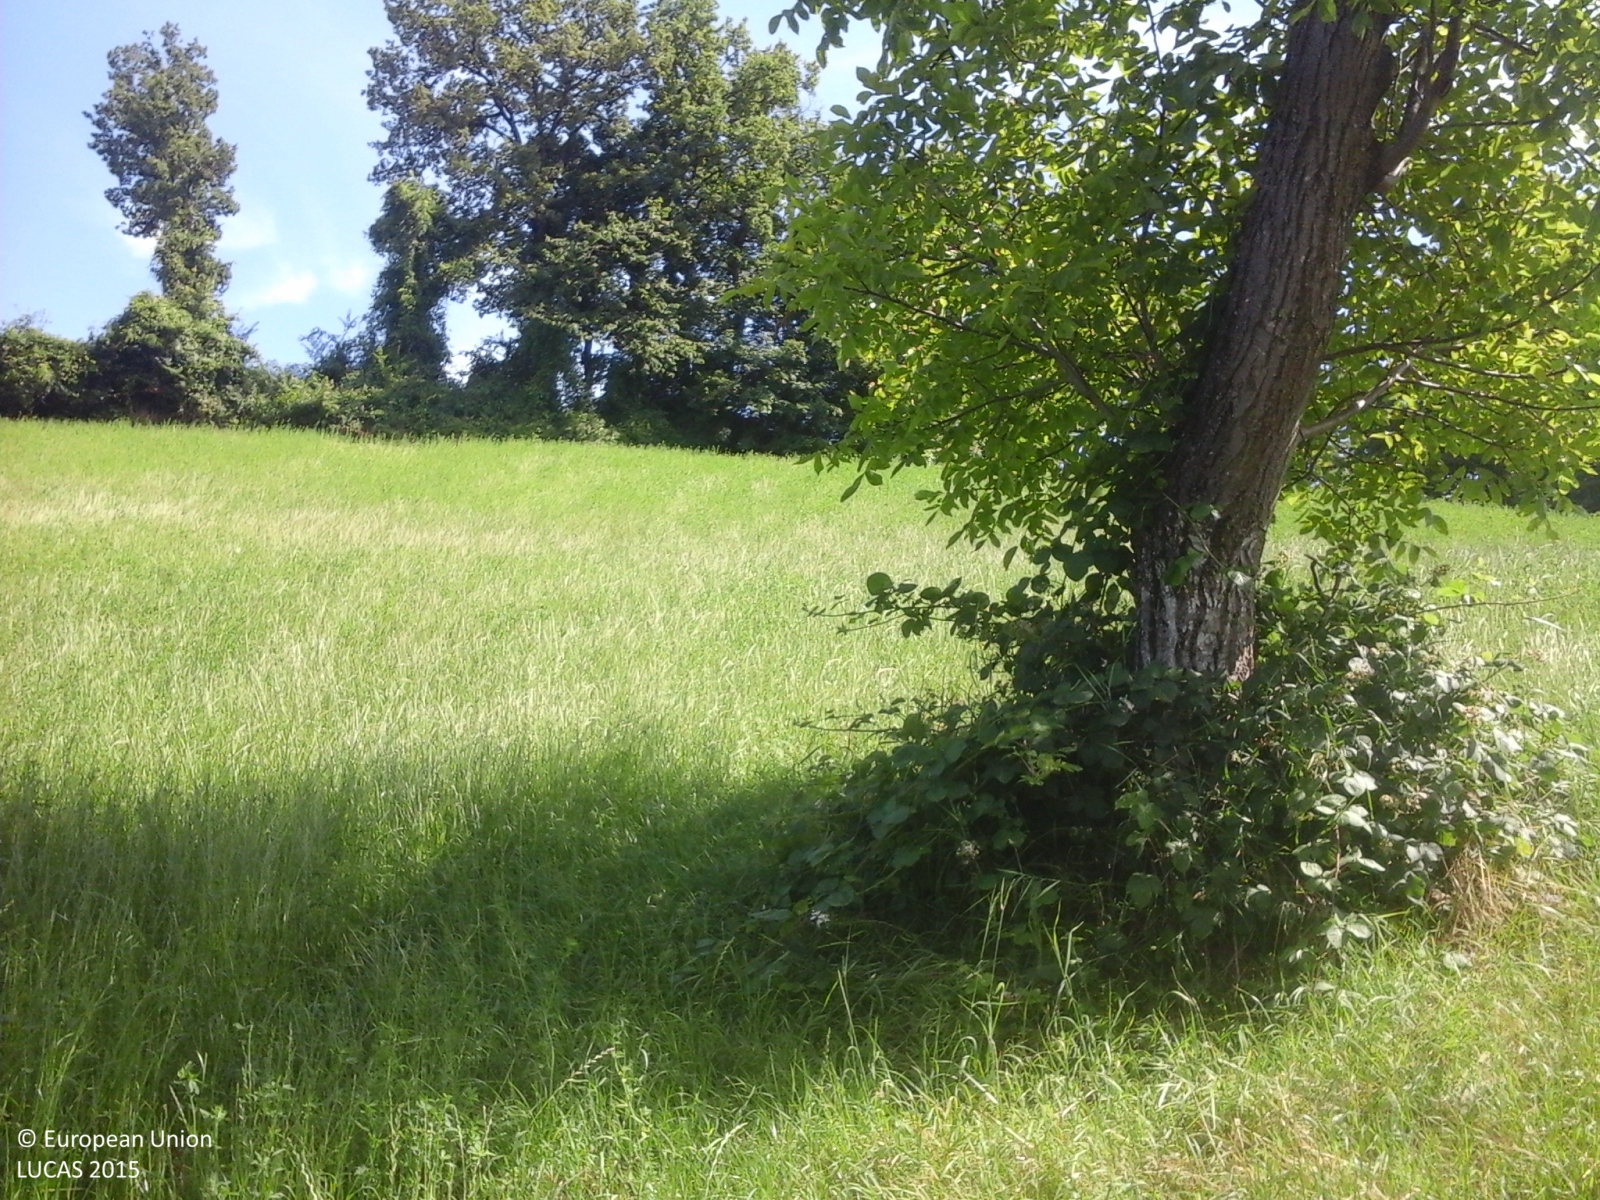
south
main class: Cropland
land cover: Lucerne
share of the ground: > 75 %
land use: Agriculture (excluding fallow land and kitchen gardens)
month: June
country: IT
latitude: 44.4932
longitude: 10.5897
